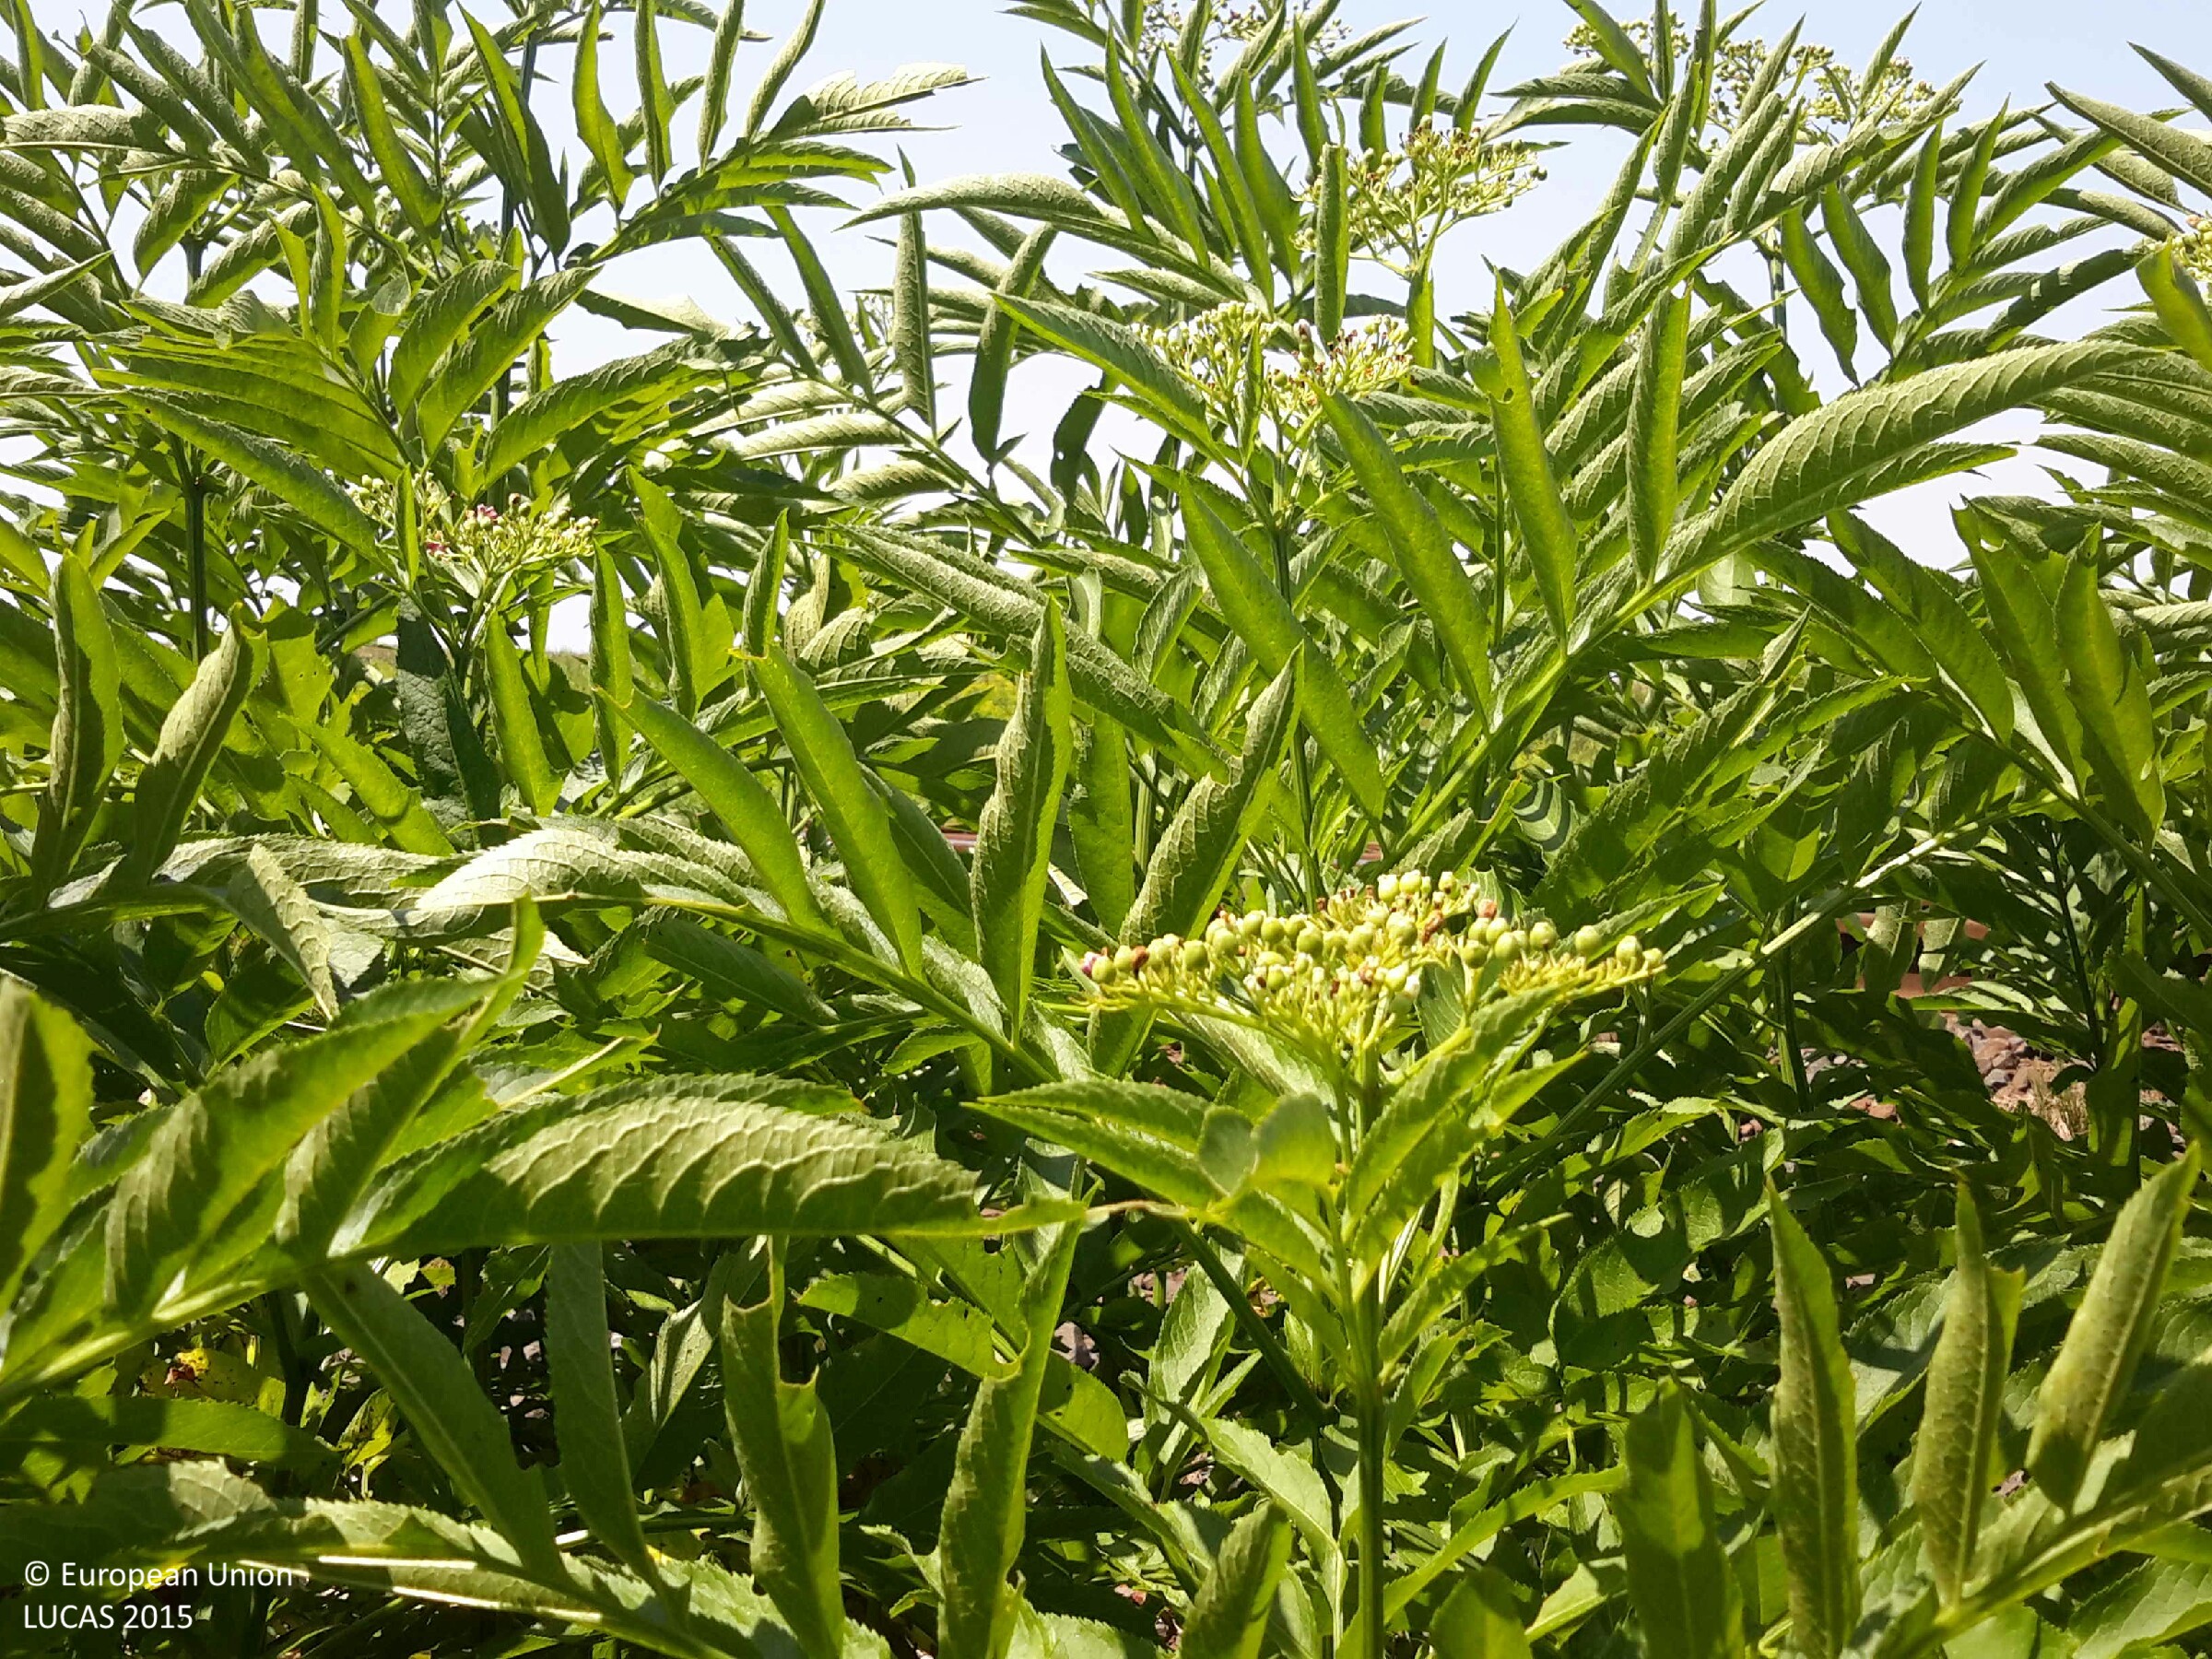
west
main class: Shrubland
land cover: Shrubland with sparse tree cover
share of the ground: 25 - 50 %
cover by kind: herbaceous plants 70 %, shrubs 25 %, broadleaved forest trees 5 %
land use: Semi-natural and natural areas not in use
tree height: > 5 m
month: July
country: HU
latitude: 47.4393
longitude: 17.8197
